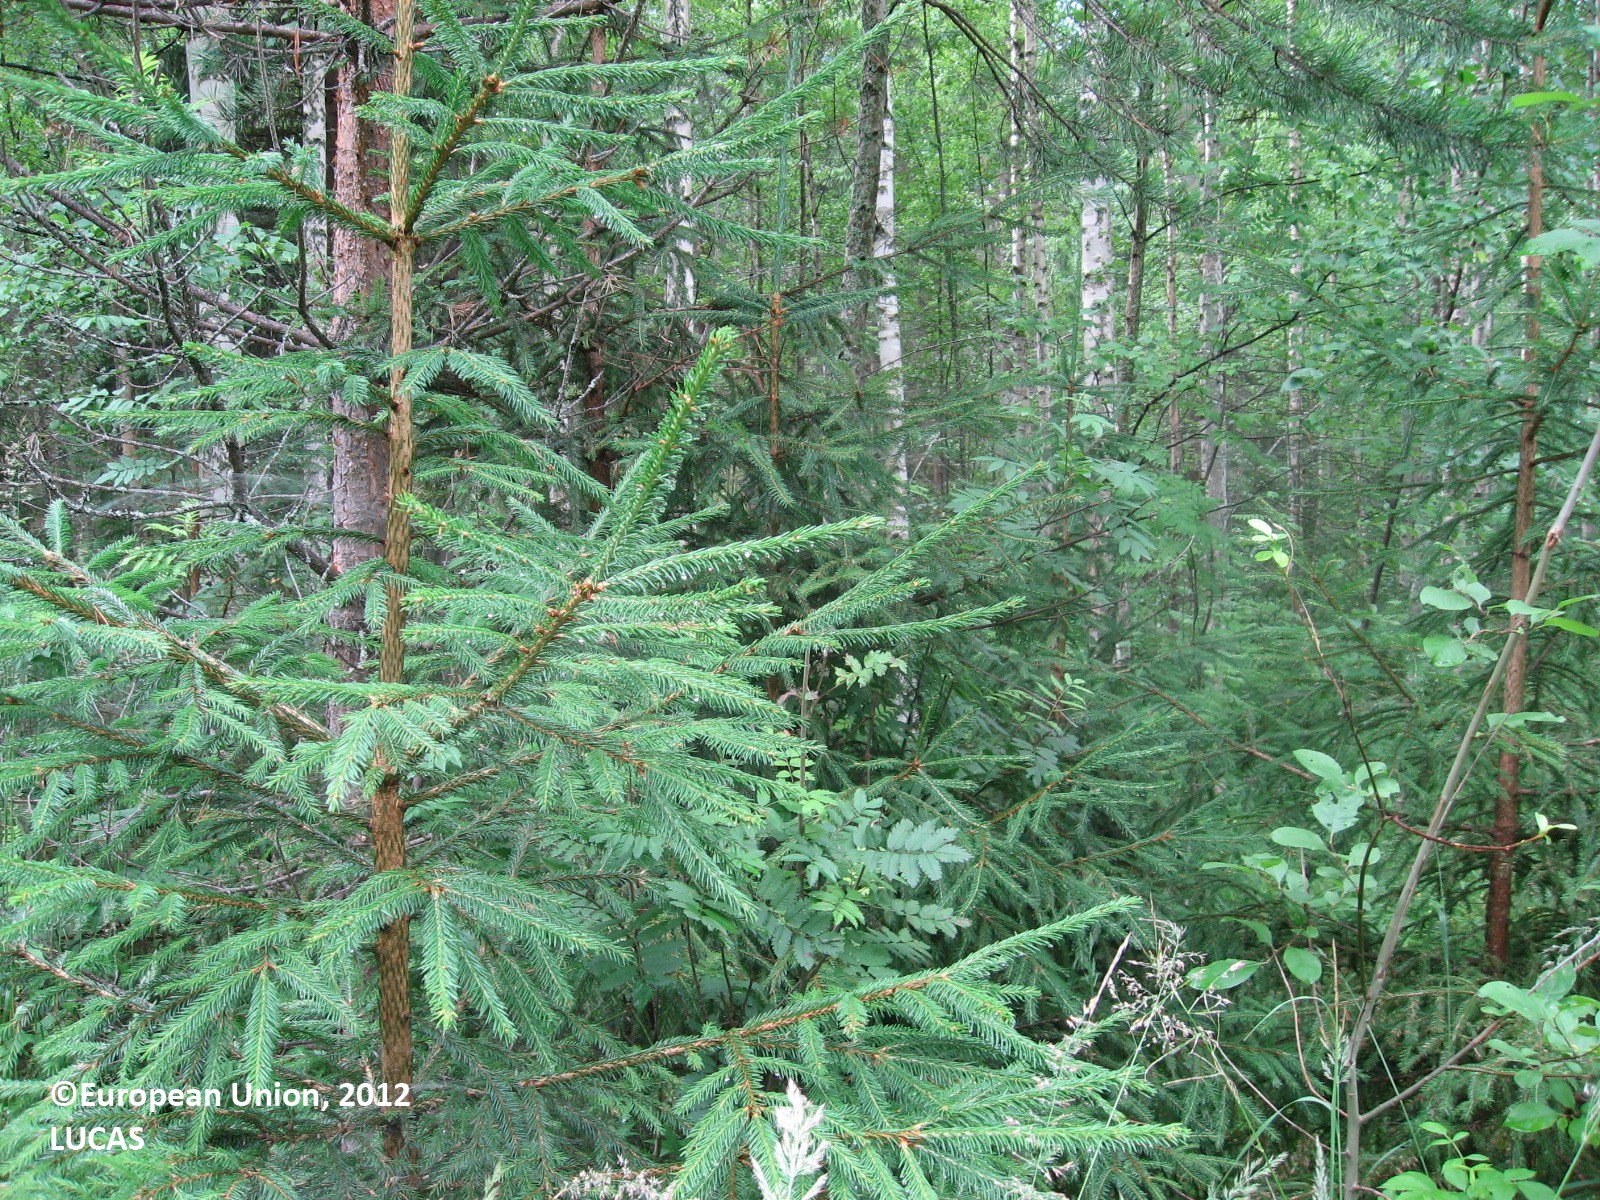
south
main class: Shrubland
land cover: Shrubland with sparse tree cover
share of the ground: > 75 %
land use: Forestry
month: July
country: FI
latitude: 61.2796
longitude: 25.8965
